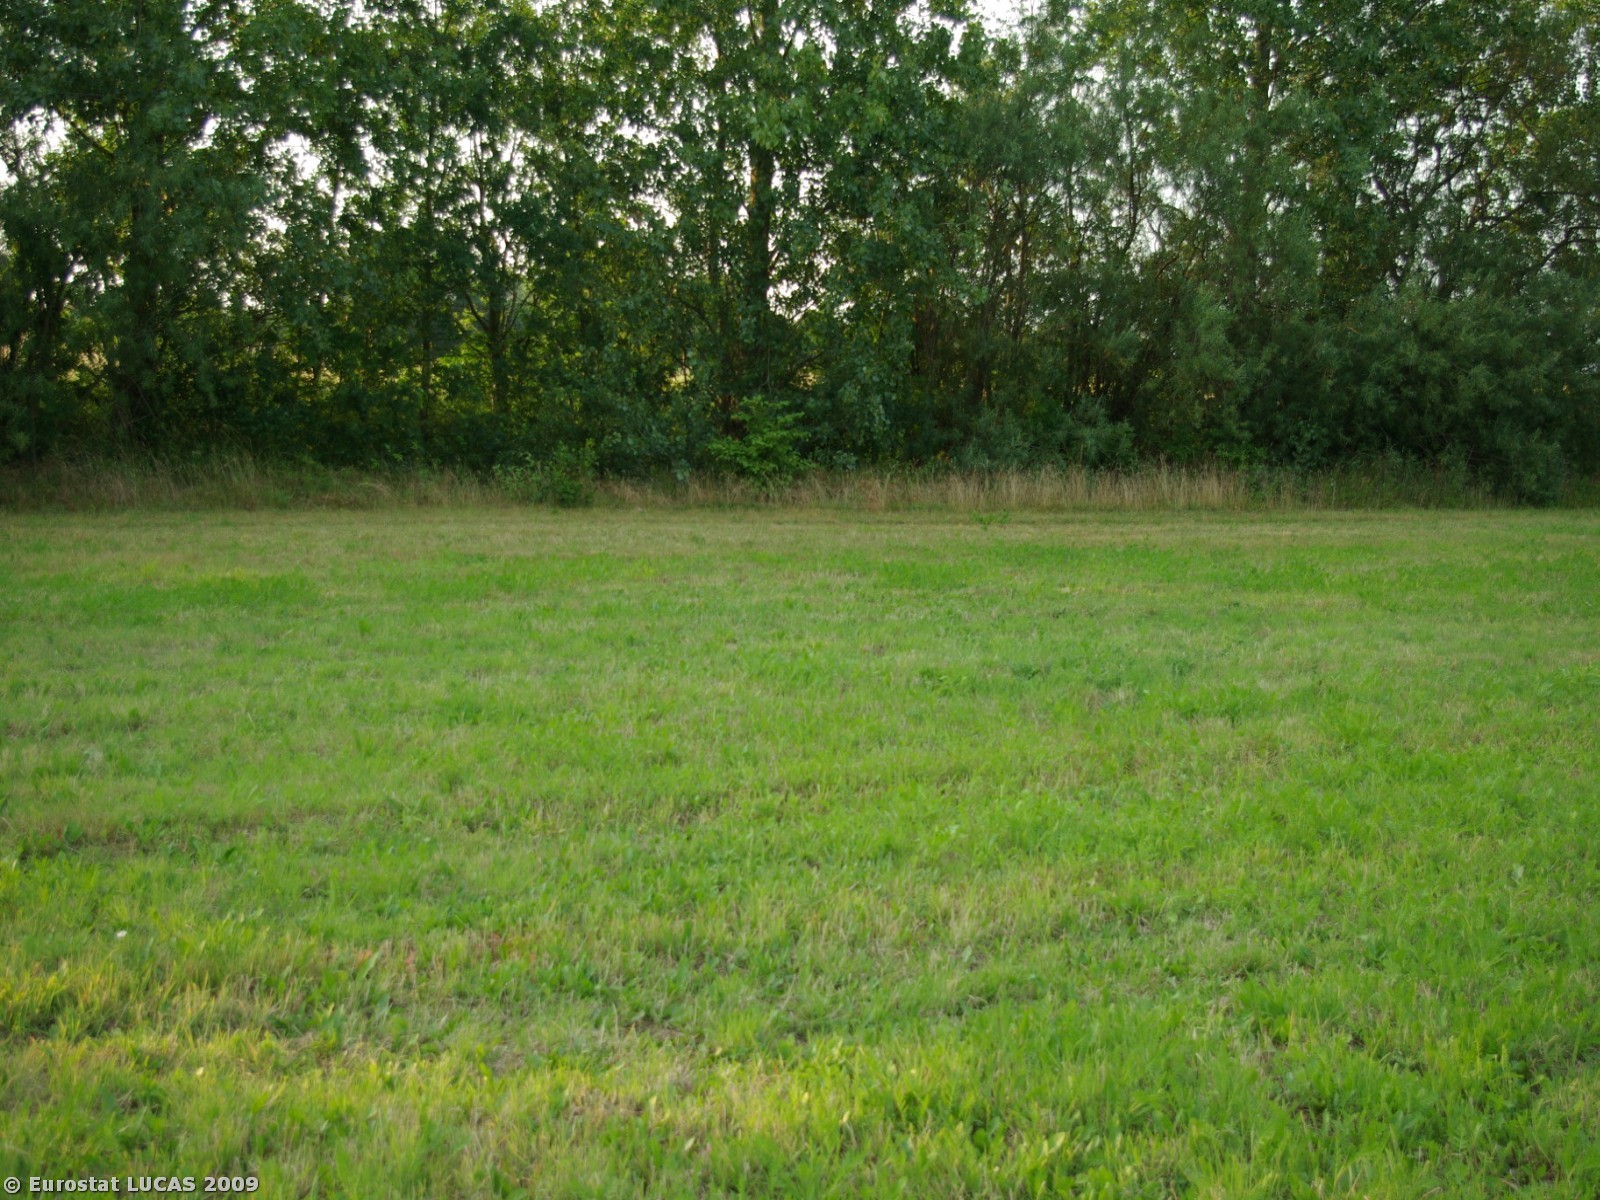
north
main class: Grassland
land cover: Grassland without tree/shrub cover
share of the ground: > 75 %
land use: Agriculture (excluding fallow land and kitchen gardens)
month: July
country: DK
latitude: 54.9294
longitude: 9.7973
